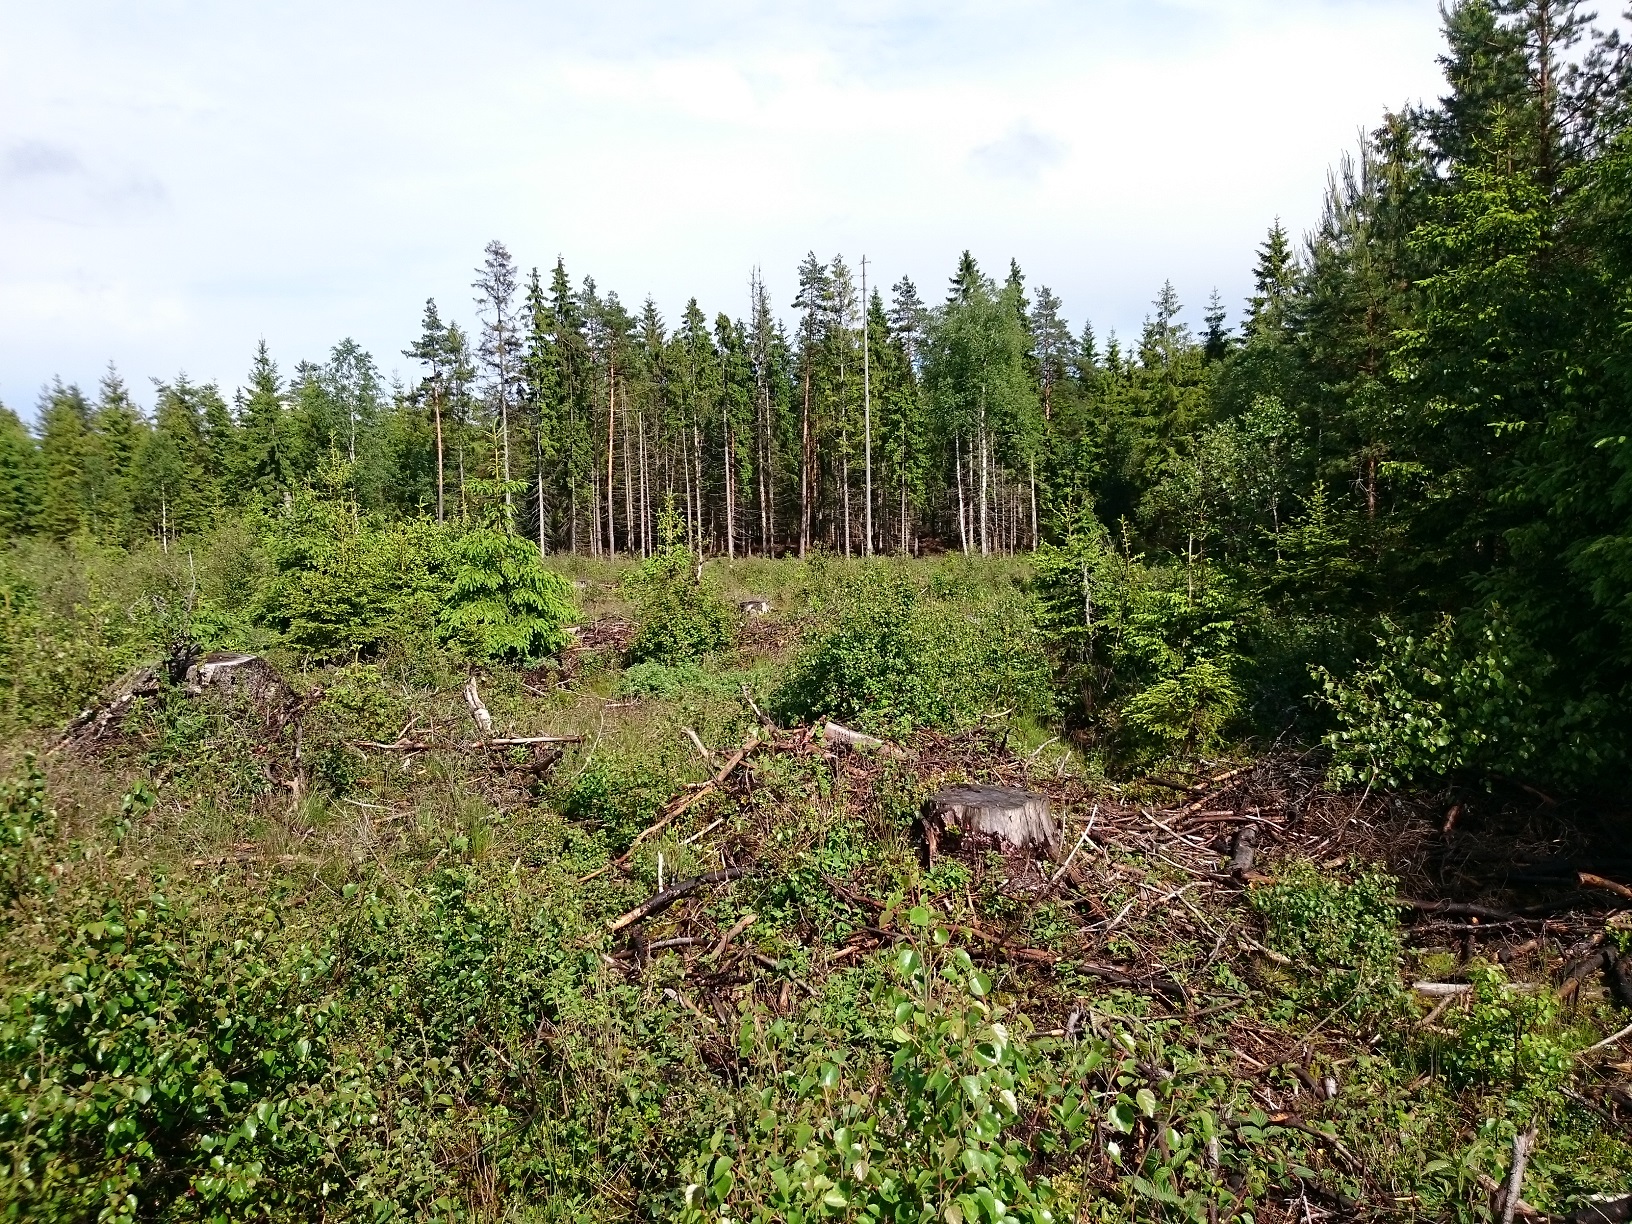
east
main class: Woodland
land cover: Spruce dominated mixed woodland
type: boreal forest
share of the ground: 25 - 50 %
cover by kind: shrubs 30 %, coniferous forest trees 25 %, broadleaved forest trees 25 %, herbaceous plants 10 %, lichens and mosses 10 %
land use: Forestry
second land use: Amenities, museums, leisure
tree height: < 5 m
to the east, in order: Spruce dominated mixed woodland; Spruce dominated coniferous woodland; Ditches and canals; Spruce dominated coniferous woodland; Pine dominated mixed woodland; Pine dominated coniferous woodland
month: June
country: SE
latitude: 56.9793
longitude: 14.3238
